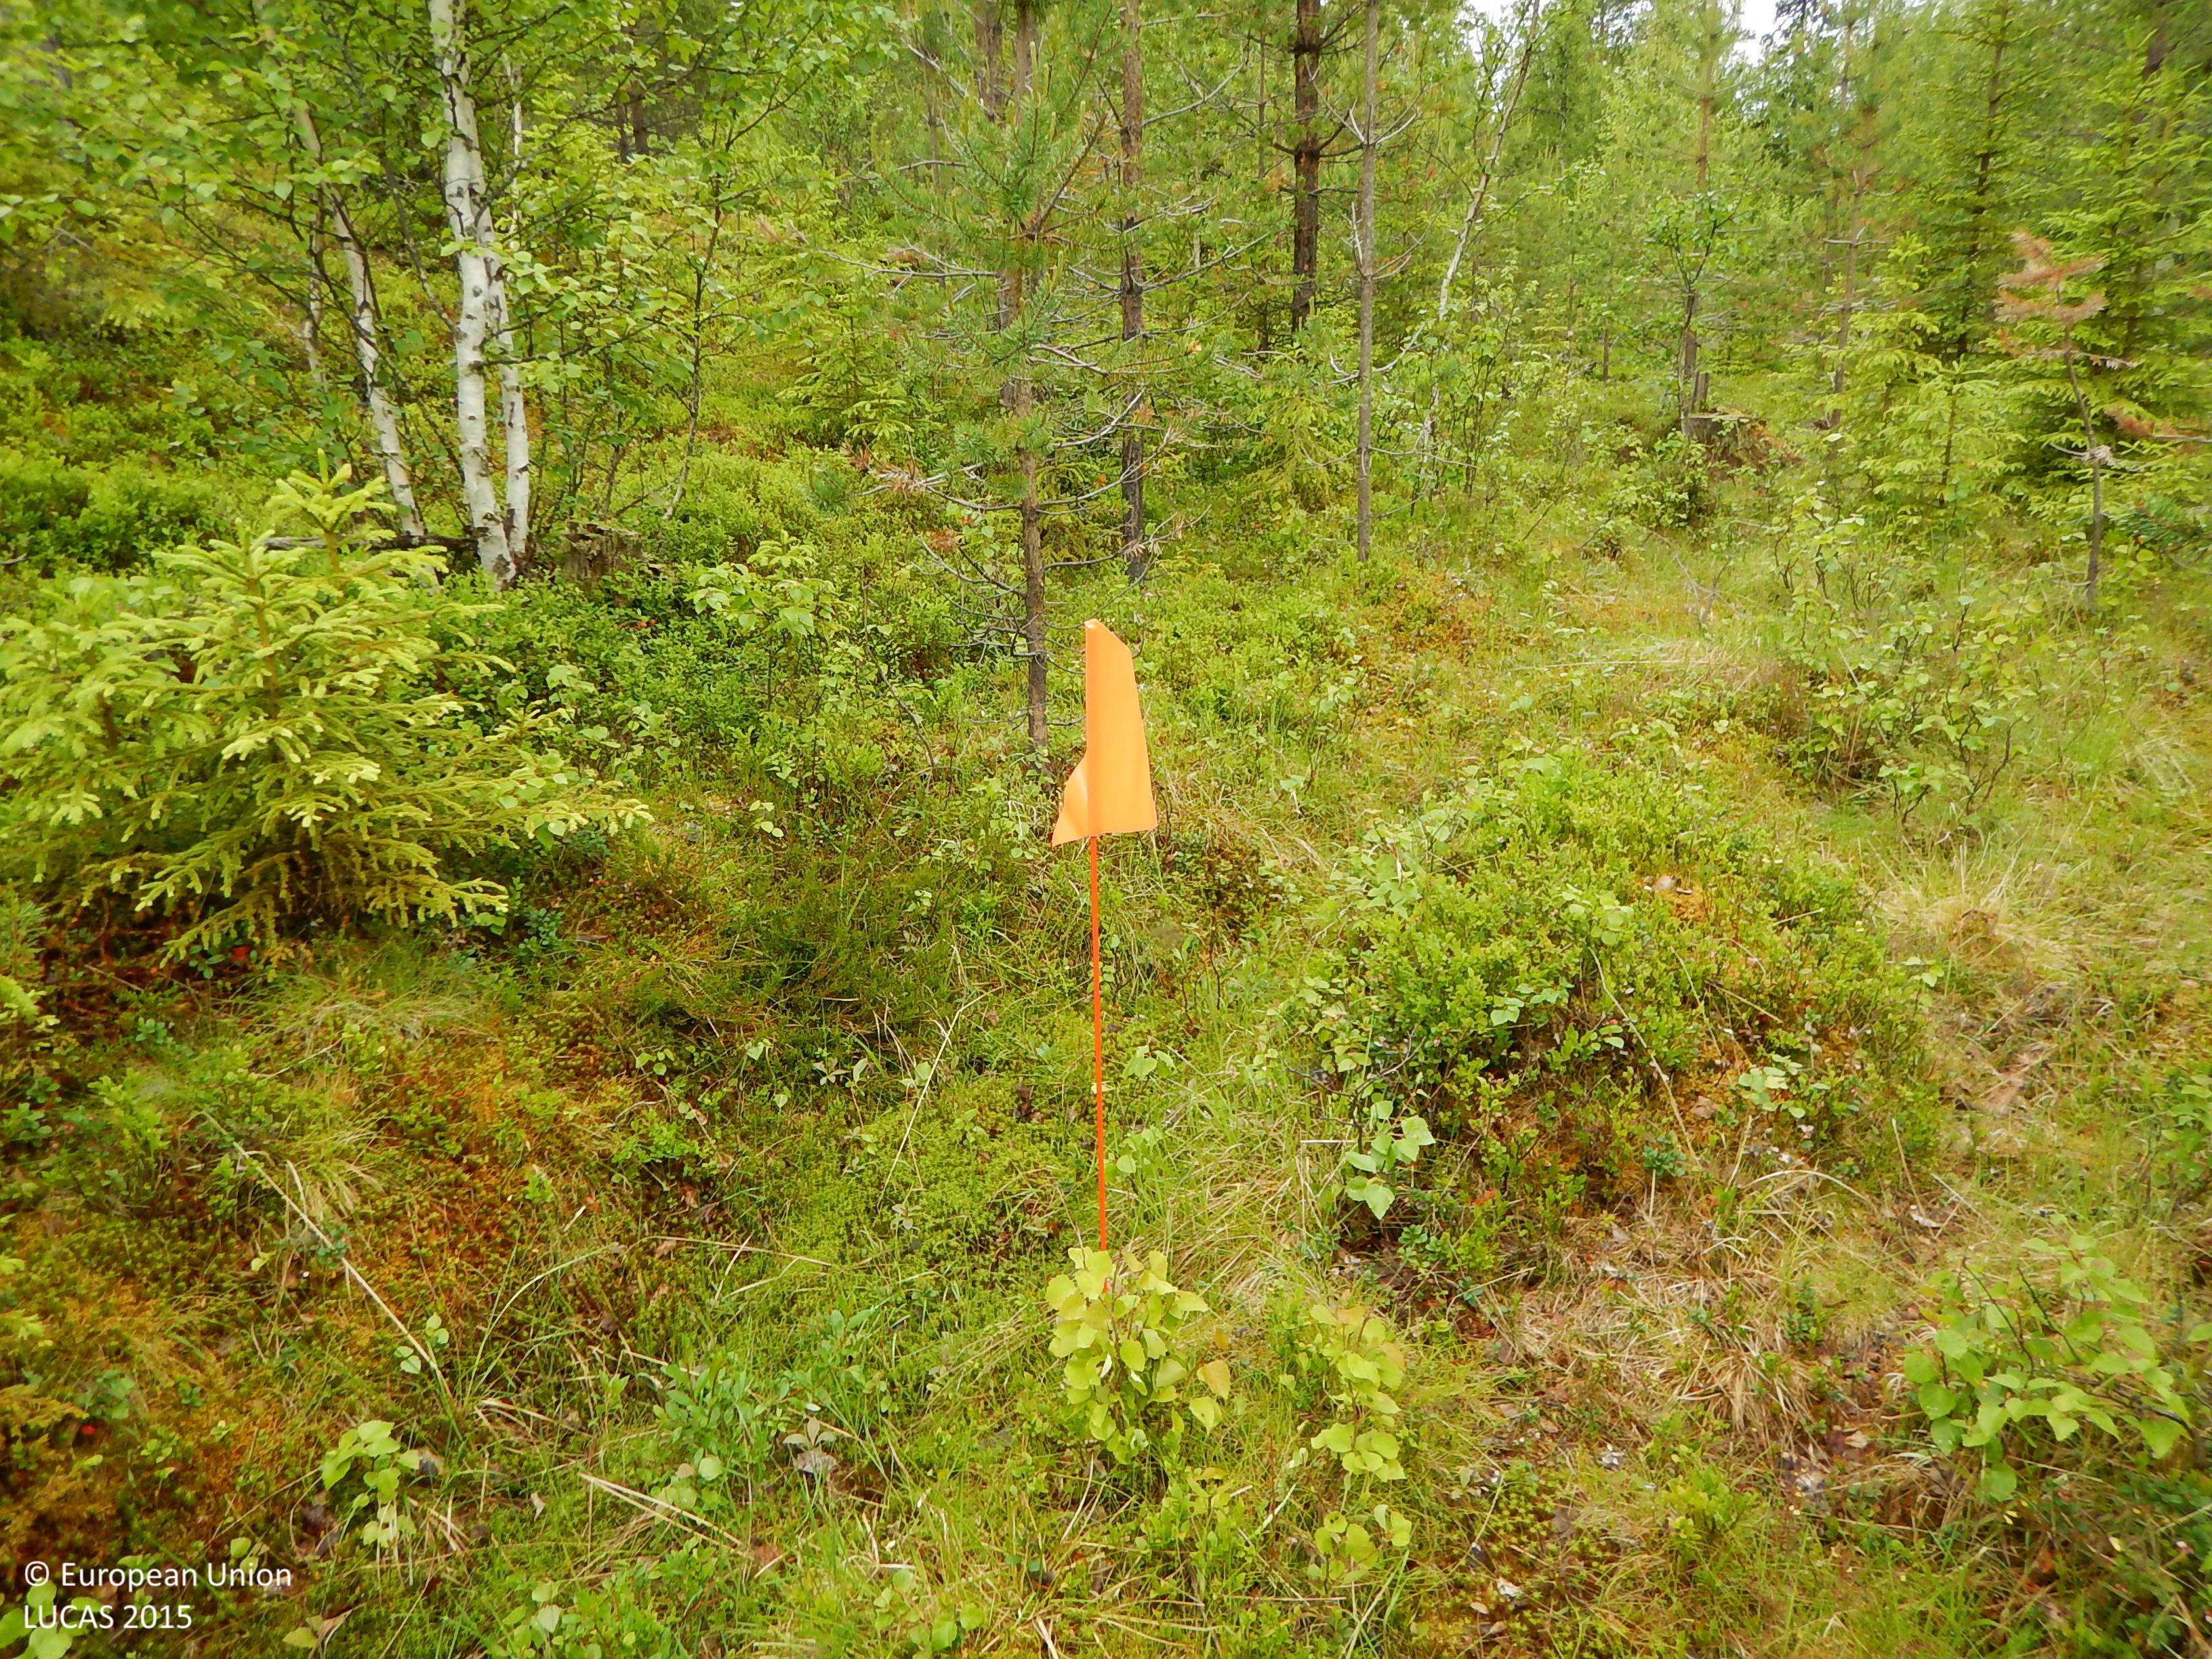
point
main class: Woodland
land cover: Pine dominated mixed woodland
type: boreal forest
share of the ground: 25 - 50 %
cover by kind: herbaceous plants 40 %, lichens and mosses 25 %, coniferous forest trees 20 %, broadleaved forest trees 10 %, shrubs 5 %
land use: Forestry
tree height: < 5 m
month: July
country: SE
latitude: 65.1626
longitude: 18.6471
